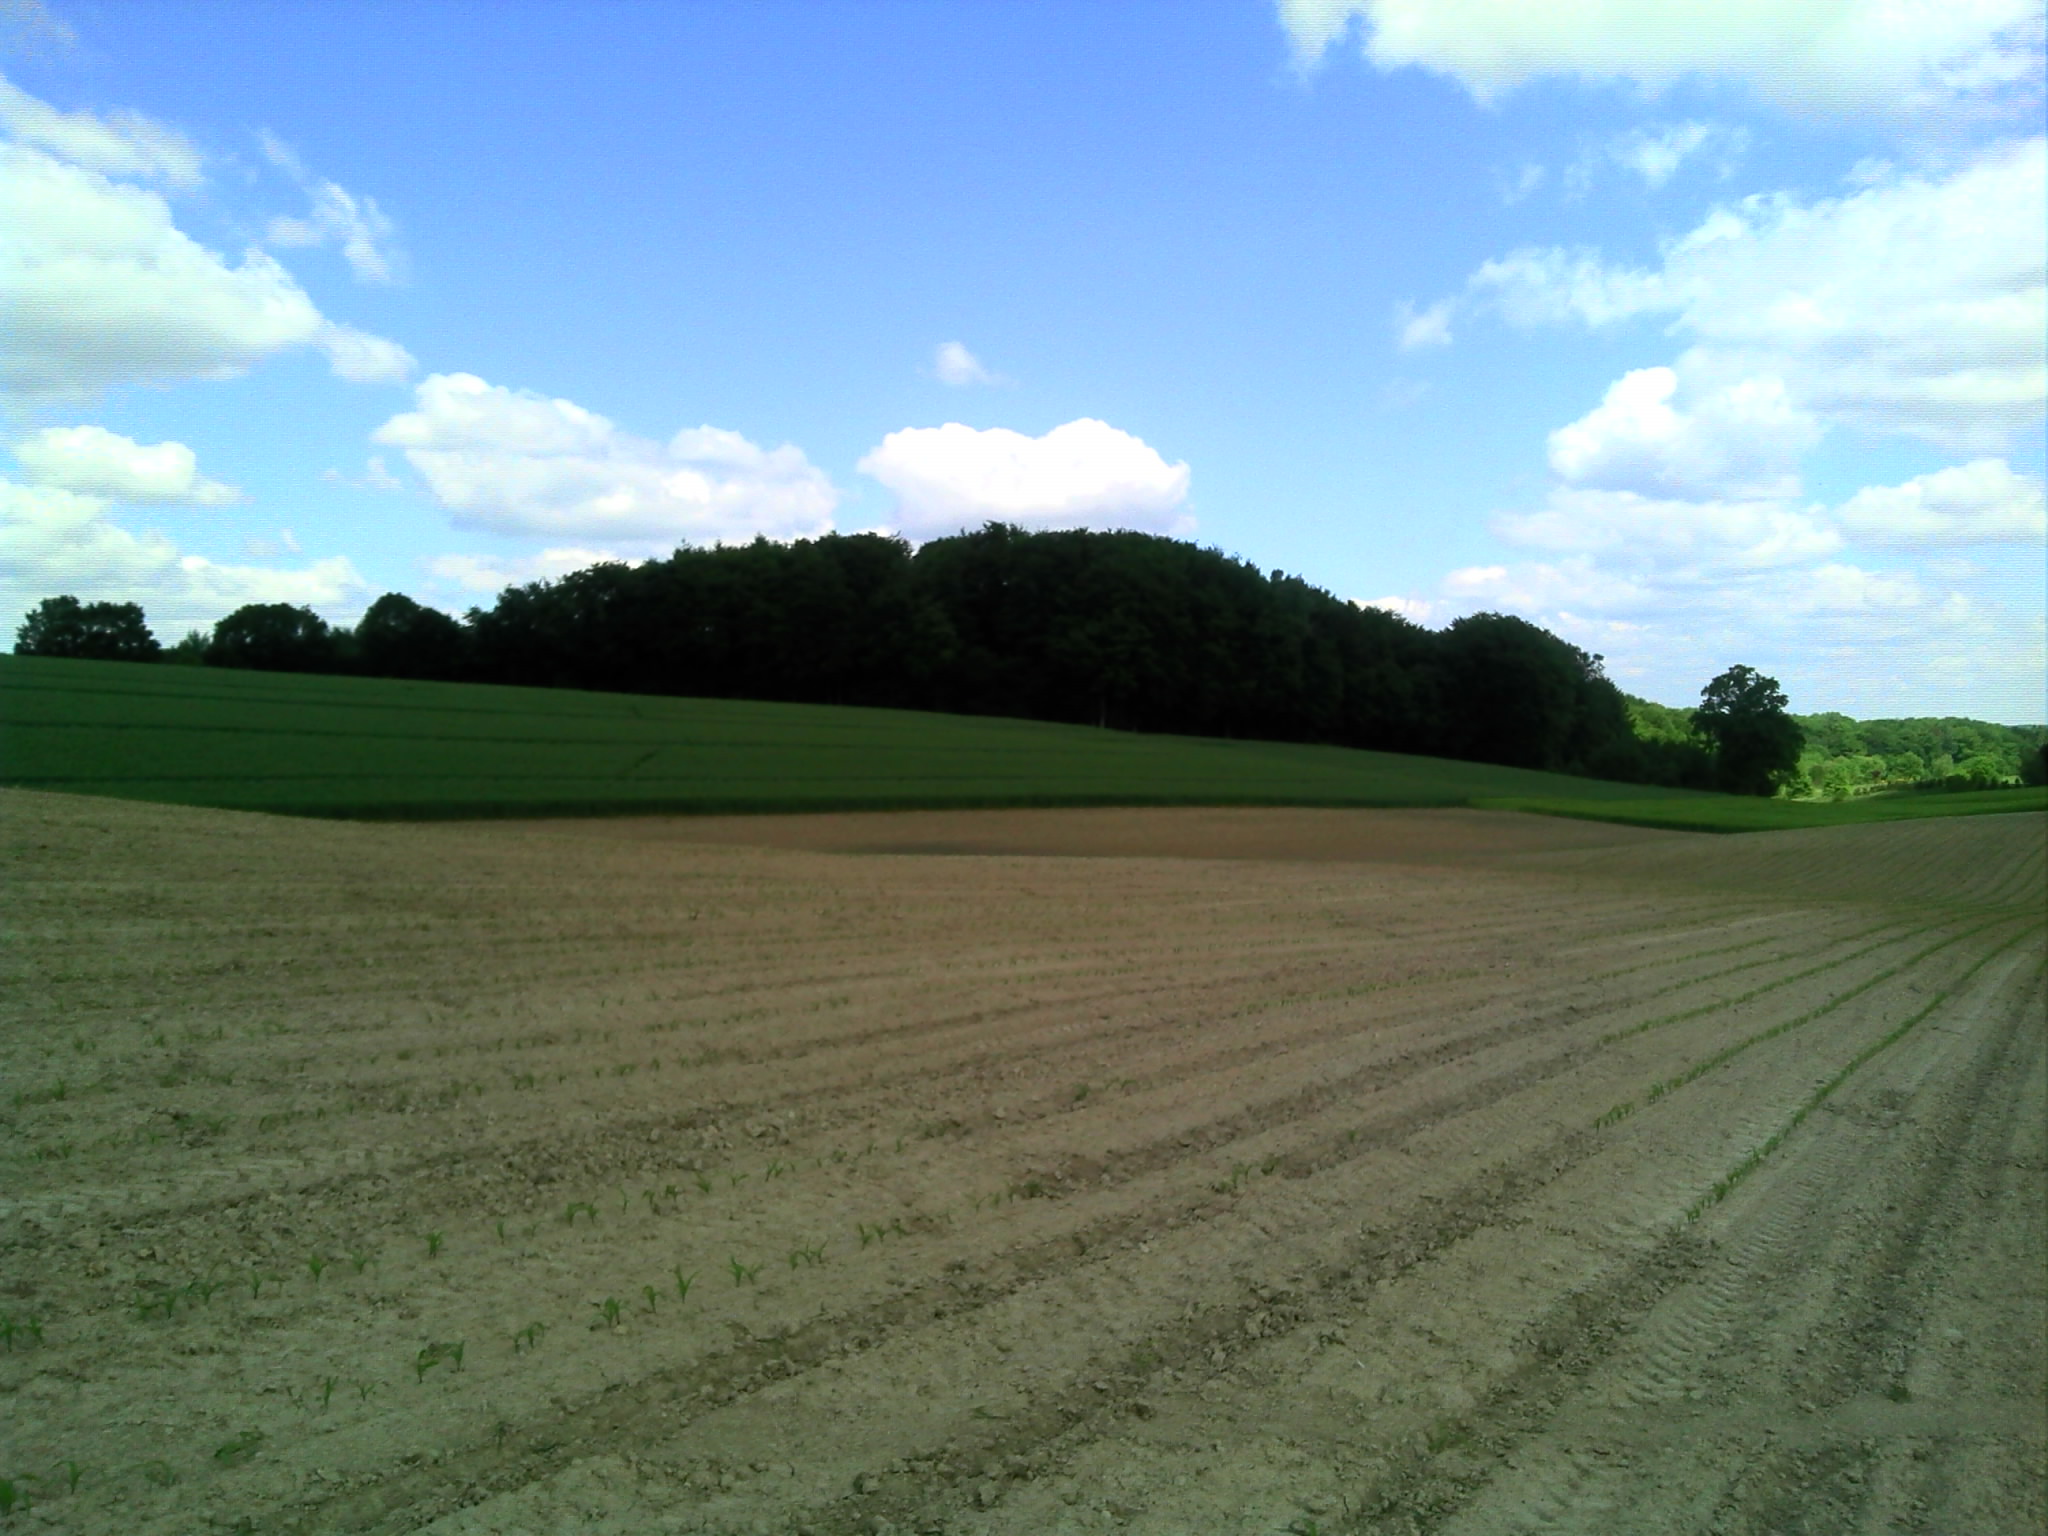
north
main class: Cropland
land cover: Maize
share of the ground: > 75 %
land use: Agriculture (excluding fallow land and kitchen gardens)
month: May
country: LU
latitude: 49.5844
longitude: 6.3065
